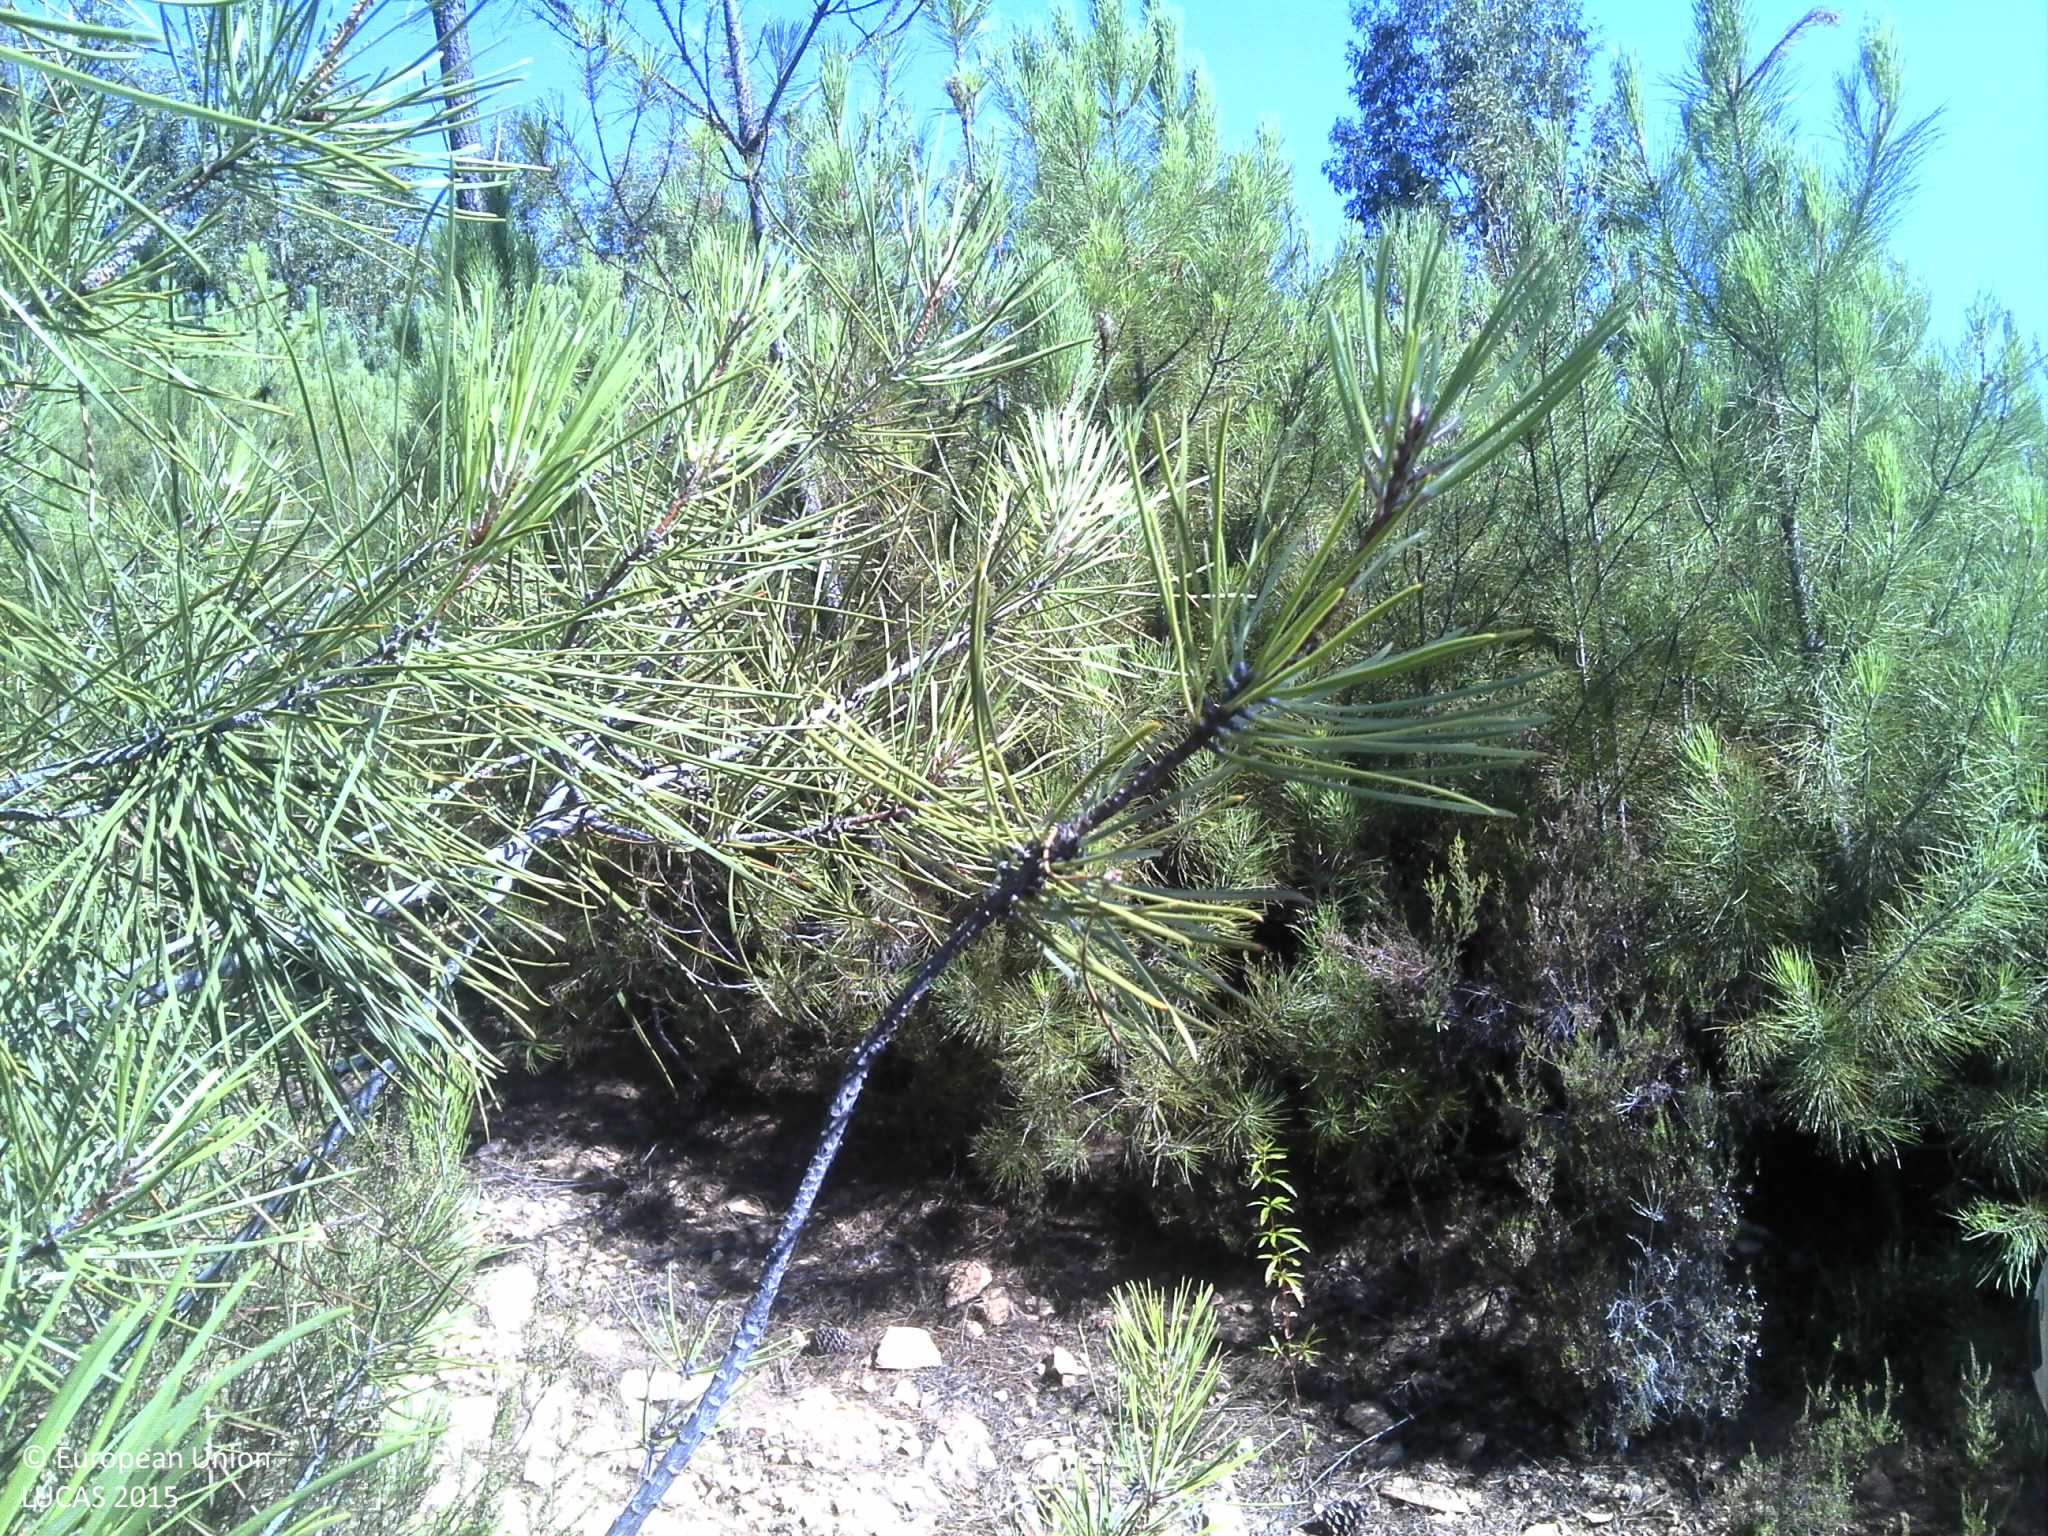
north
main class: Woodland
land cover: Pine dominated coniferous woodland
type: coniferous forest of the mediterranean region
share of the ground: 25 - 50 %
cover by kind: coniferous forest trees 50 %, shrubs 40 %, unconsolidated bare surface 10 %
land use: Forestry
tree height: < 5 m
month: July
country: PT
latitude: 40.0157
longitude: -7.6690
